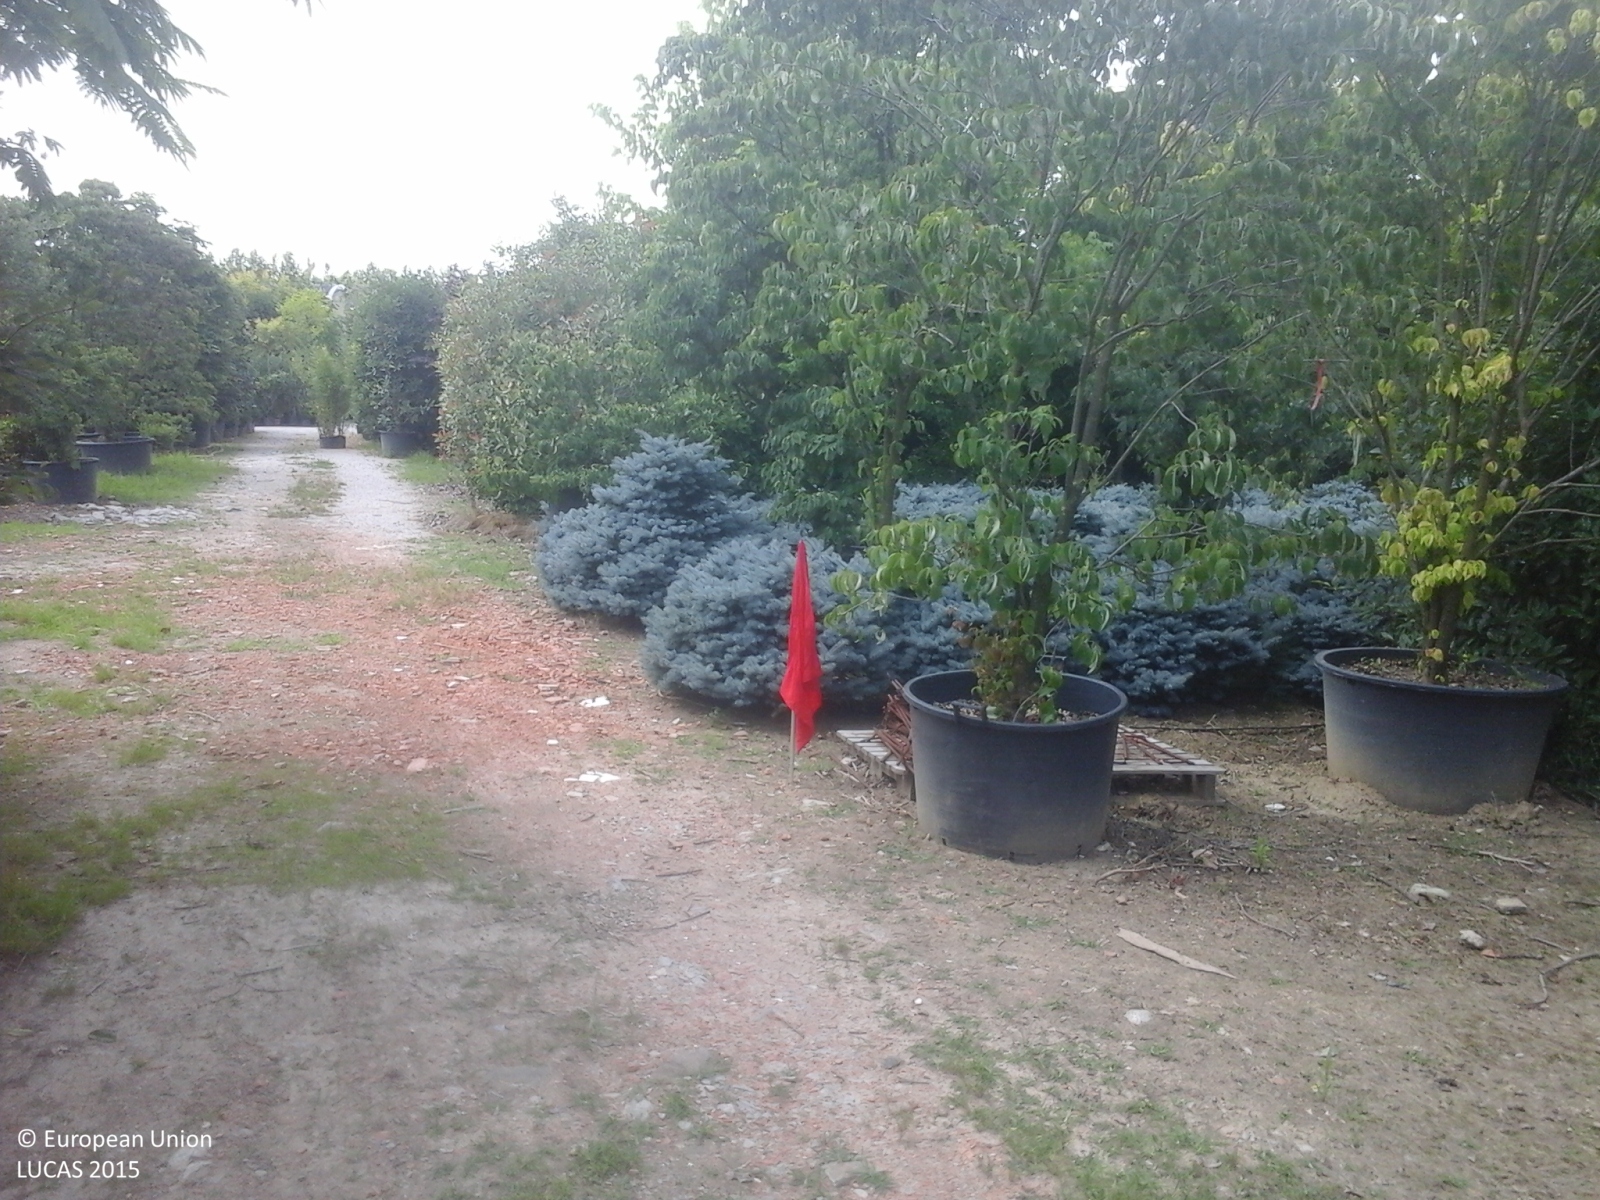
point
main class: Cropland
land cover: Nurseries
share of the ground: > 75 %
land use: Agriculture (excluding fallow land and kitchen gardens)
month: June
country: IT
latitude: 45.7189
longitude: 9.3971
